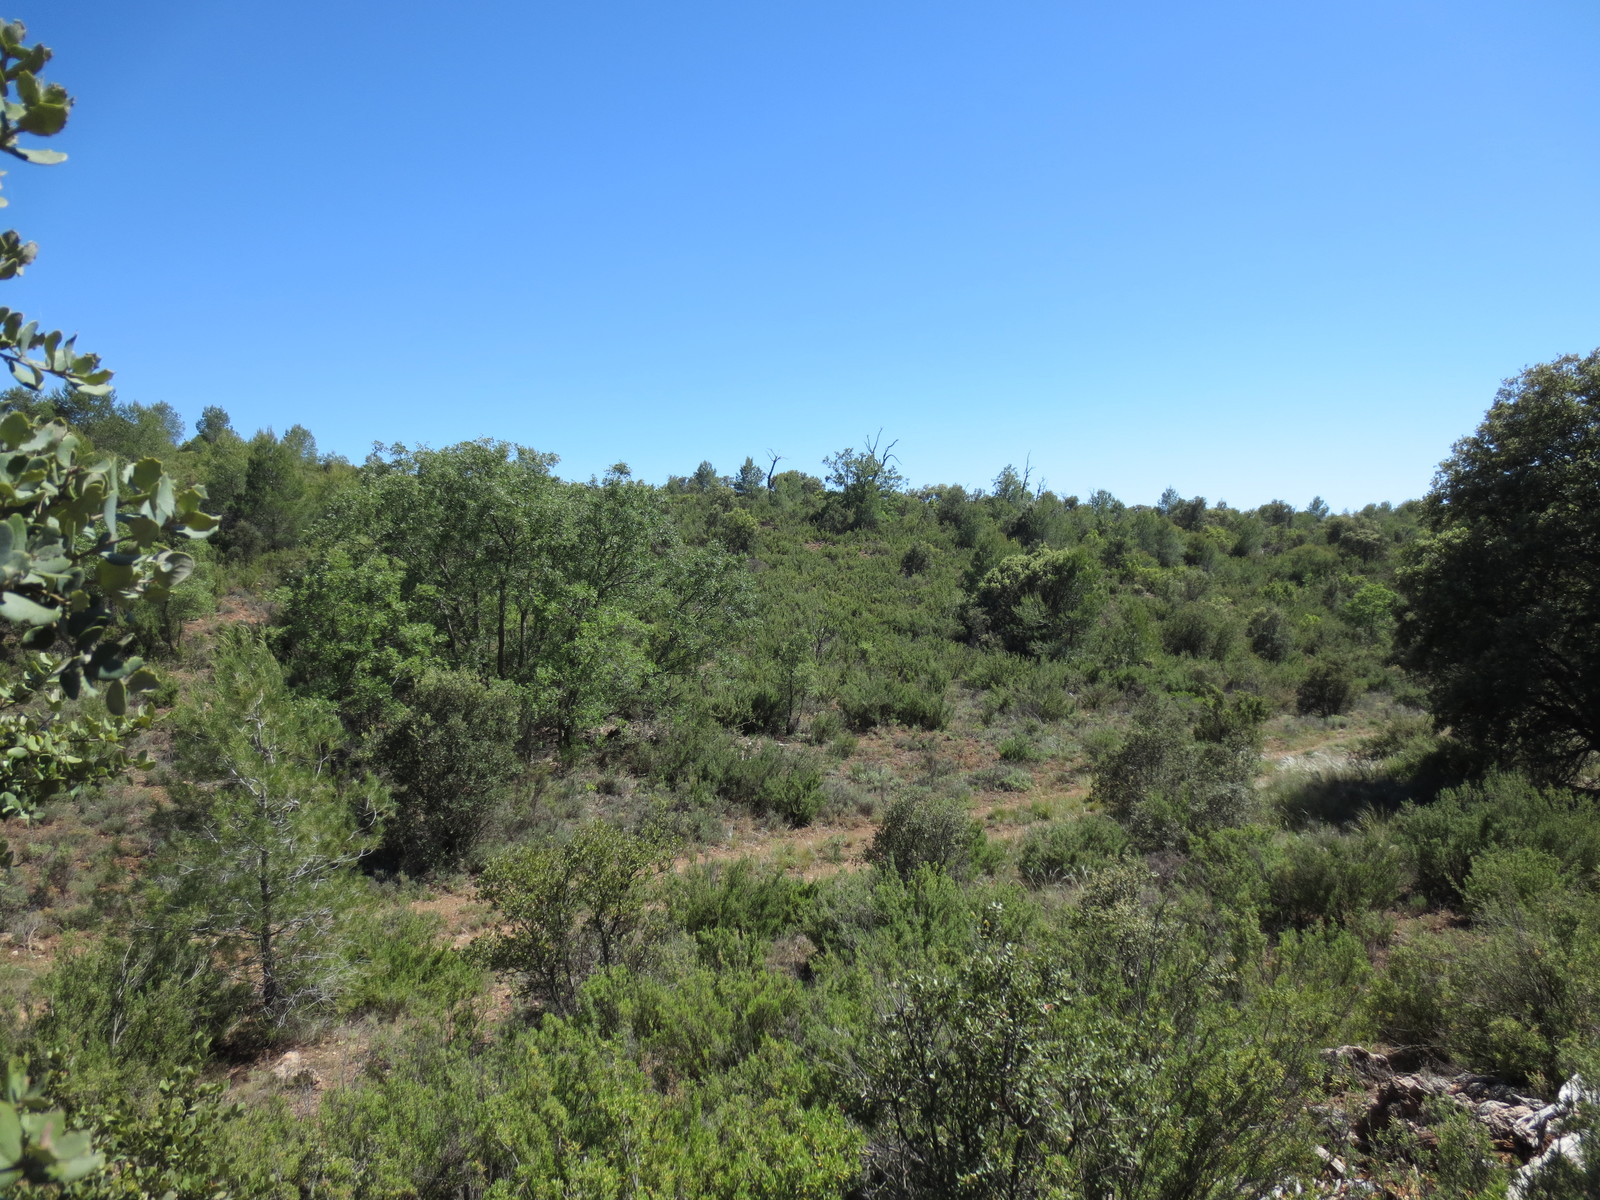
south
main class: Shrubland
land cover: Shrubland with sparse tree cover
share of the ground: > 75 %
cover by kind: shrubs 75 %, unconsolidated bare surface 20 %, coniferous forest trees 5 %
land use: Semi-natural and natural areas not in use
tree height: < 5 m
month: May
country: ES
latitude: 40.2240
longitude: -2.8458
